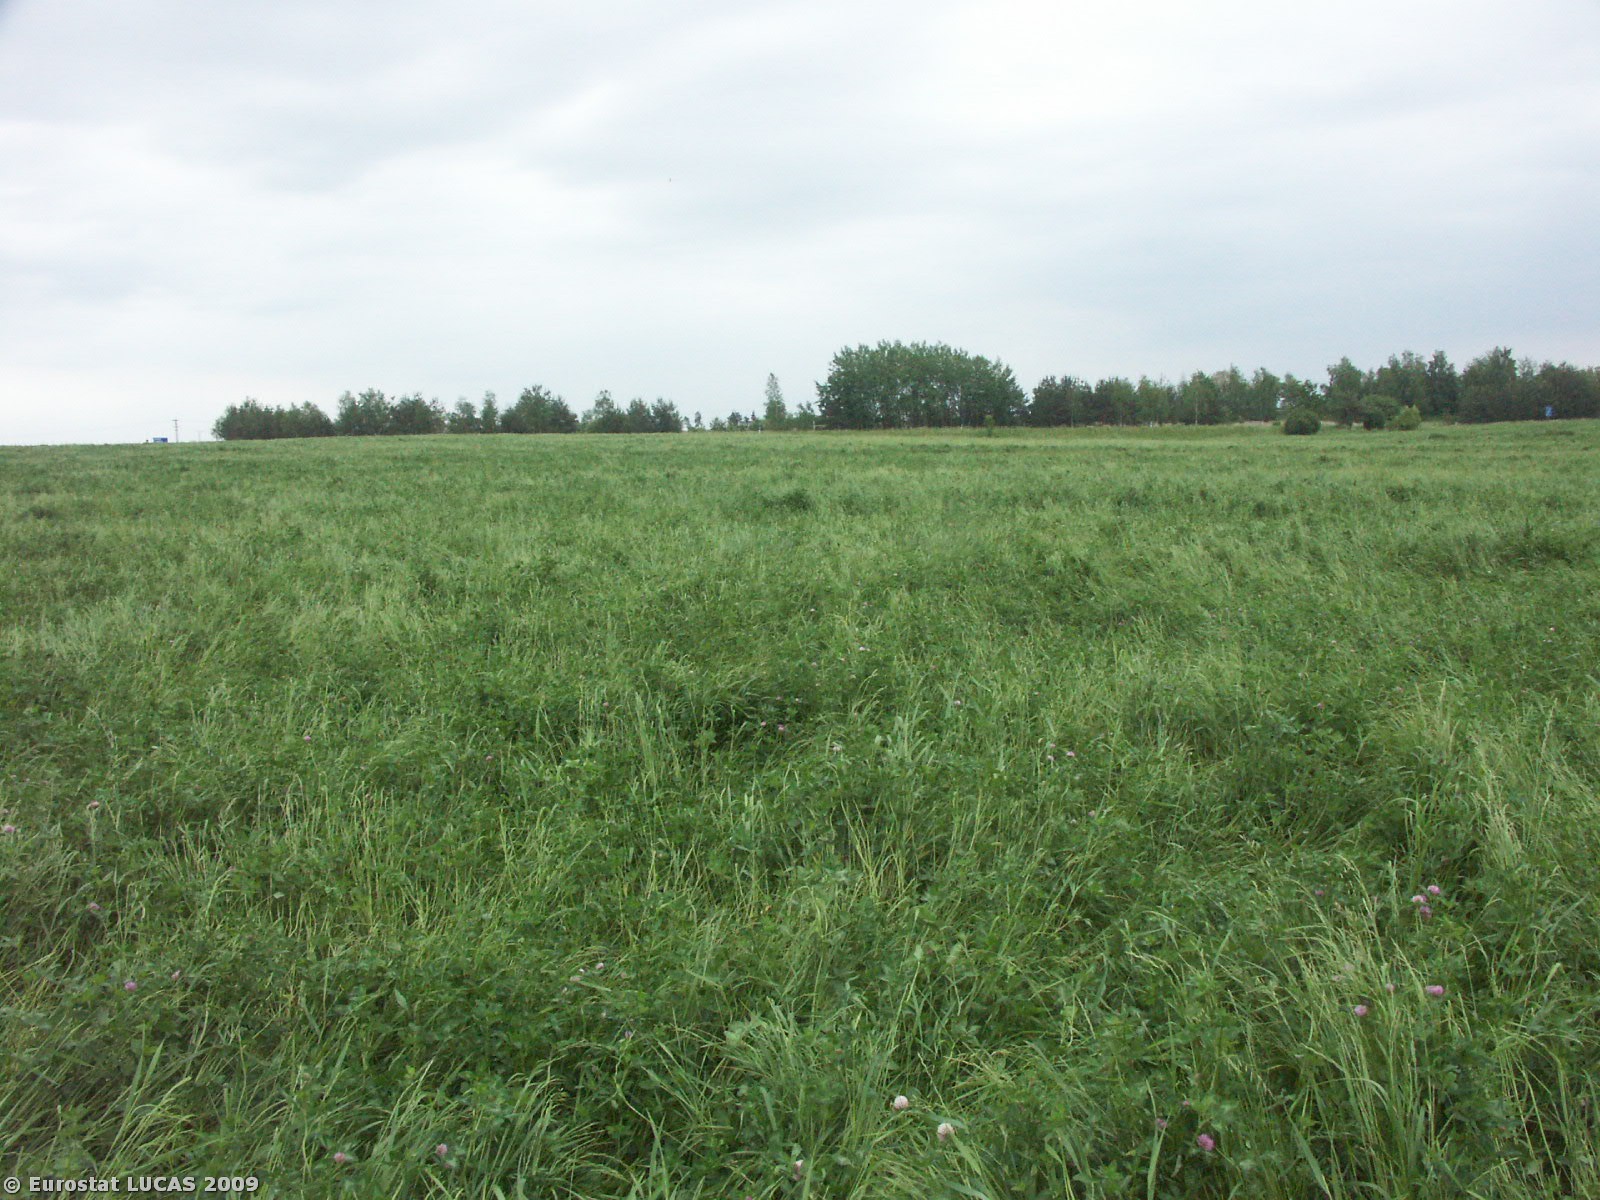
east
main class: Cropland
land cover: Temporary grasslands
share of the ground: 50 - 75 %
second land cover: Clovers
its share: 50 - 75 %
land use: Agriculture (excluding fallow land and kitchen gardens)
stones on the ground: < 10 %
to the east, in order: Temporary grasslands; Clovers; Grassland without tree/shrub cover; Paved roads, cycling and walking lanes; Grass margins; Ditches and canals; Coniferous woodland; Grassland with sparse tree/shrub cover
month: May
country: CZ
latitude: 48.8912
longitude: 14.4337
